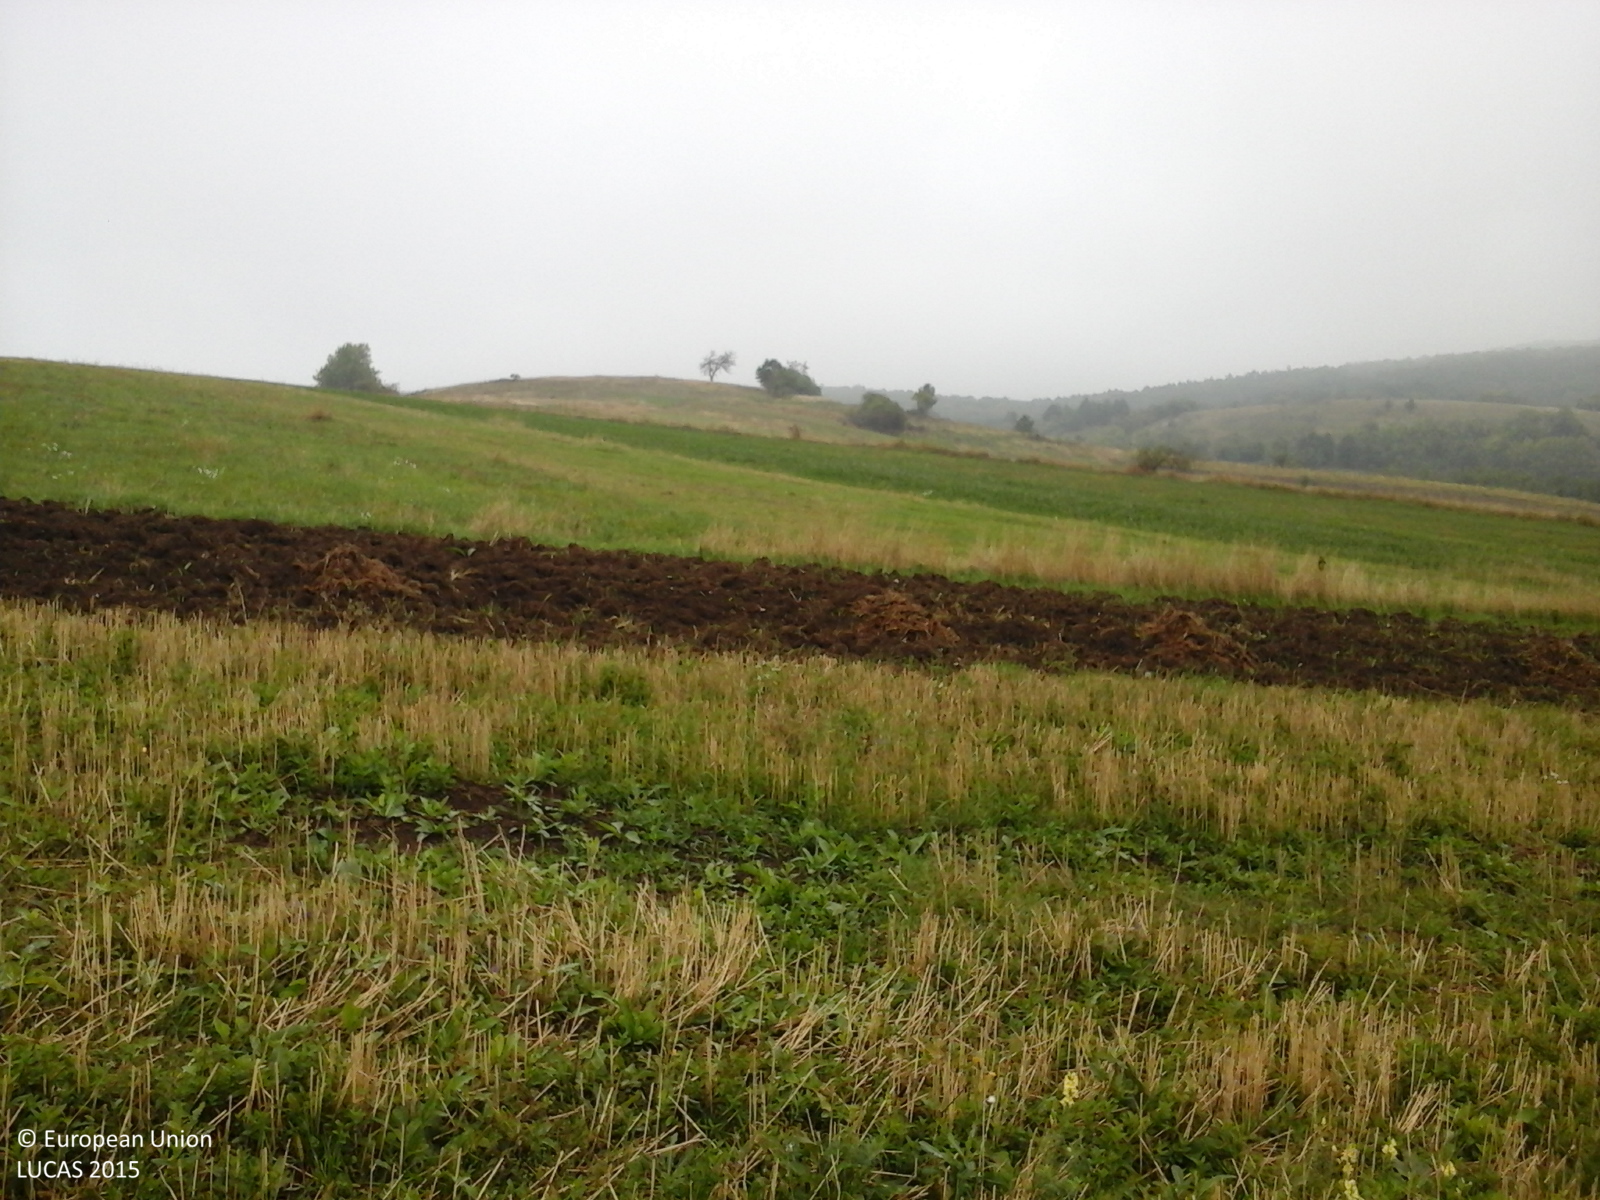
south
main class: Grassland
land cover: Grassland without tree/shrub cover
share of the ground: > 75 %
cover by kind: herbaceous plants 100 %
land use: Agriculture (excluding fallow land and kitchen gardens)
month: September
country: RO
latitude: 45.8648
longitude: 22.8438
